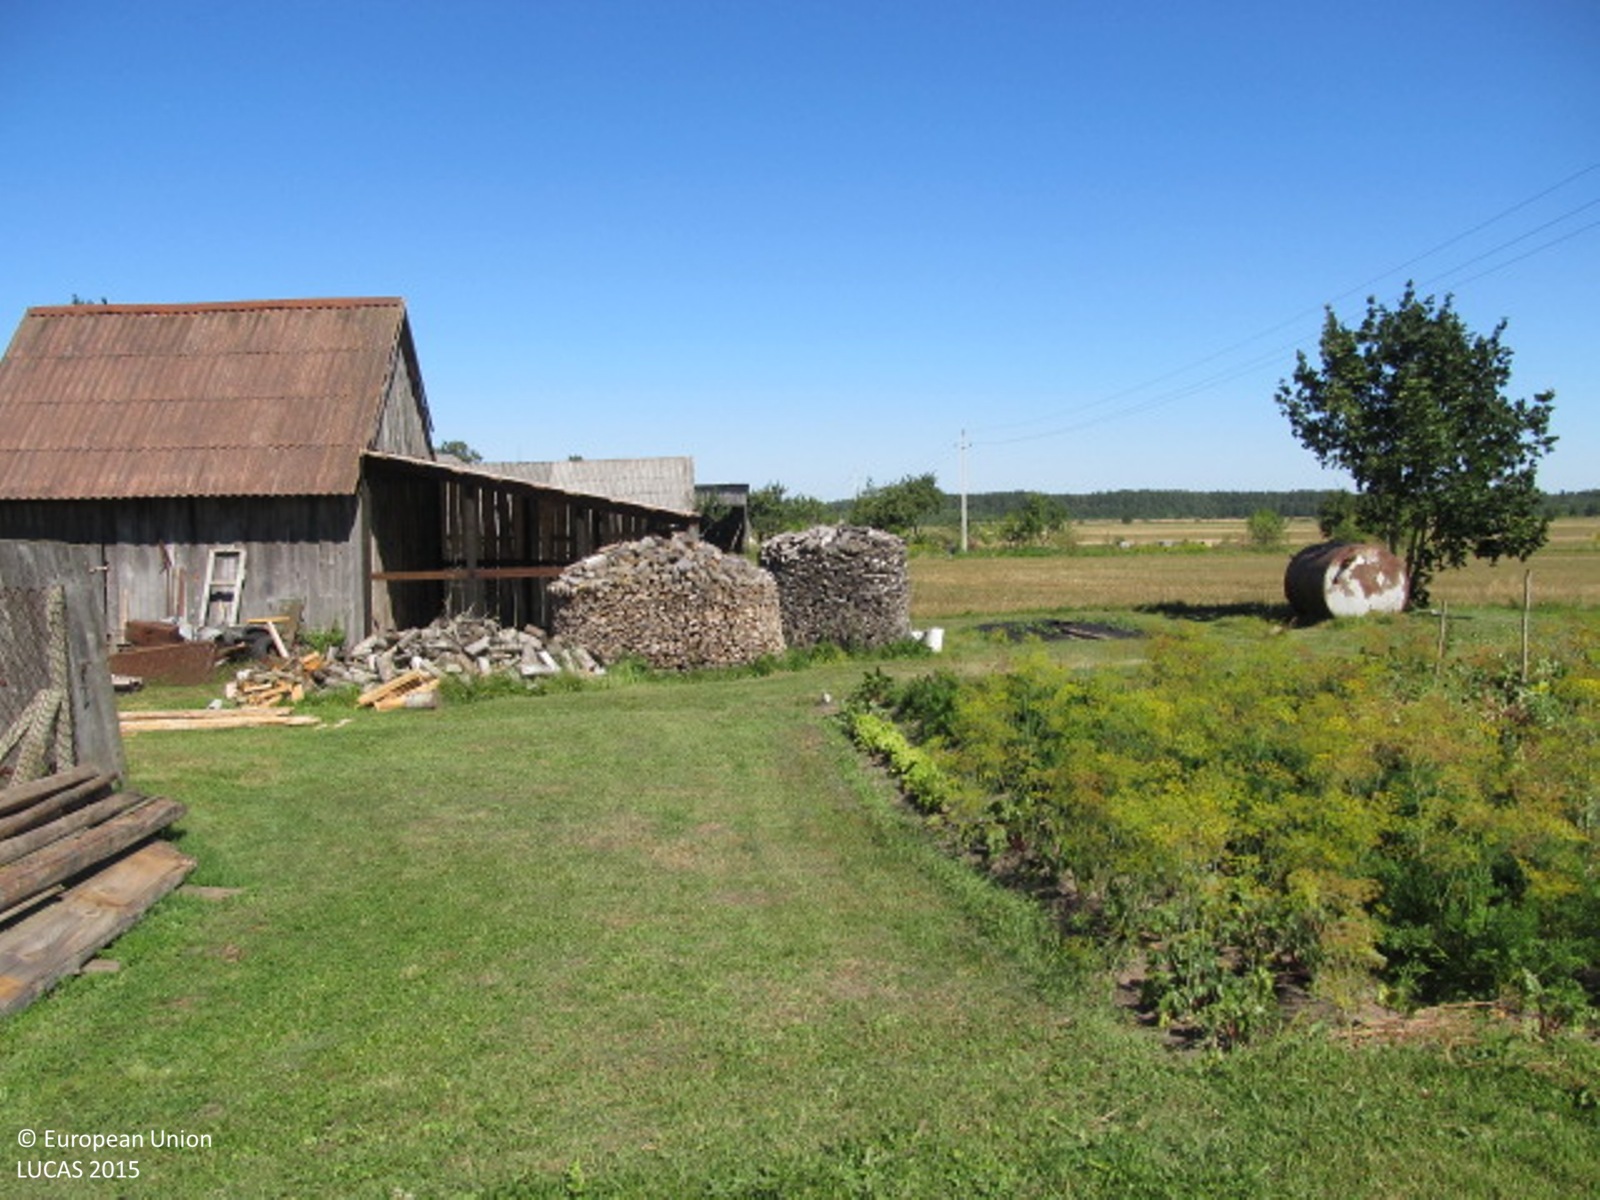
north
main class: Grassland
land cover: Grassland without tree/shrub cover
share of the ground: > 75 %
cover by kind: herbaceous plants 100 %
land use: Agriculture (excluding fallow land and kitchen gardens)
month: August
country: LT
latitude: 56.1884
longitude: 22.5471
